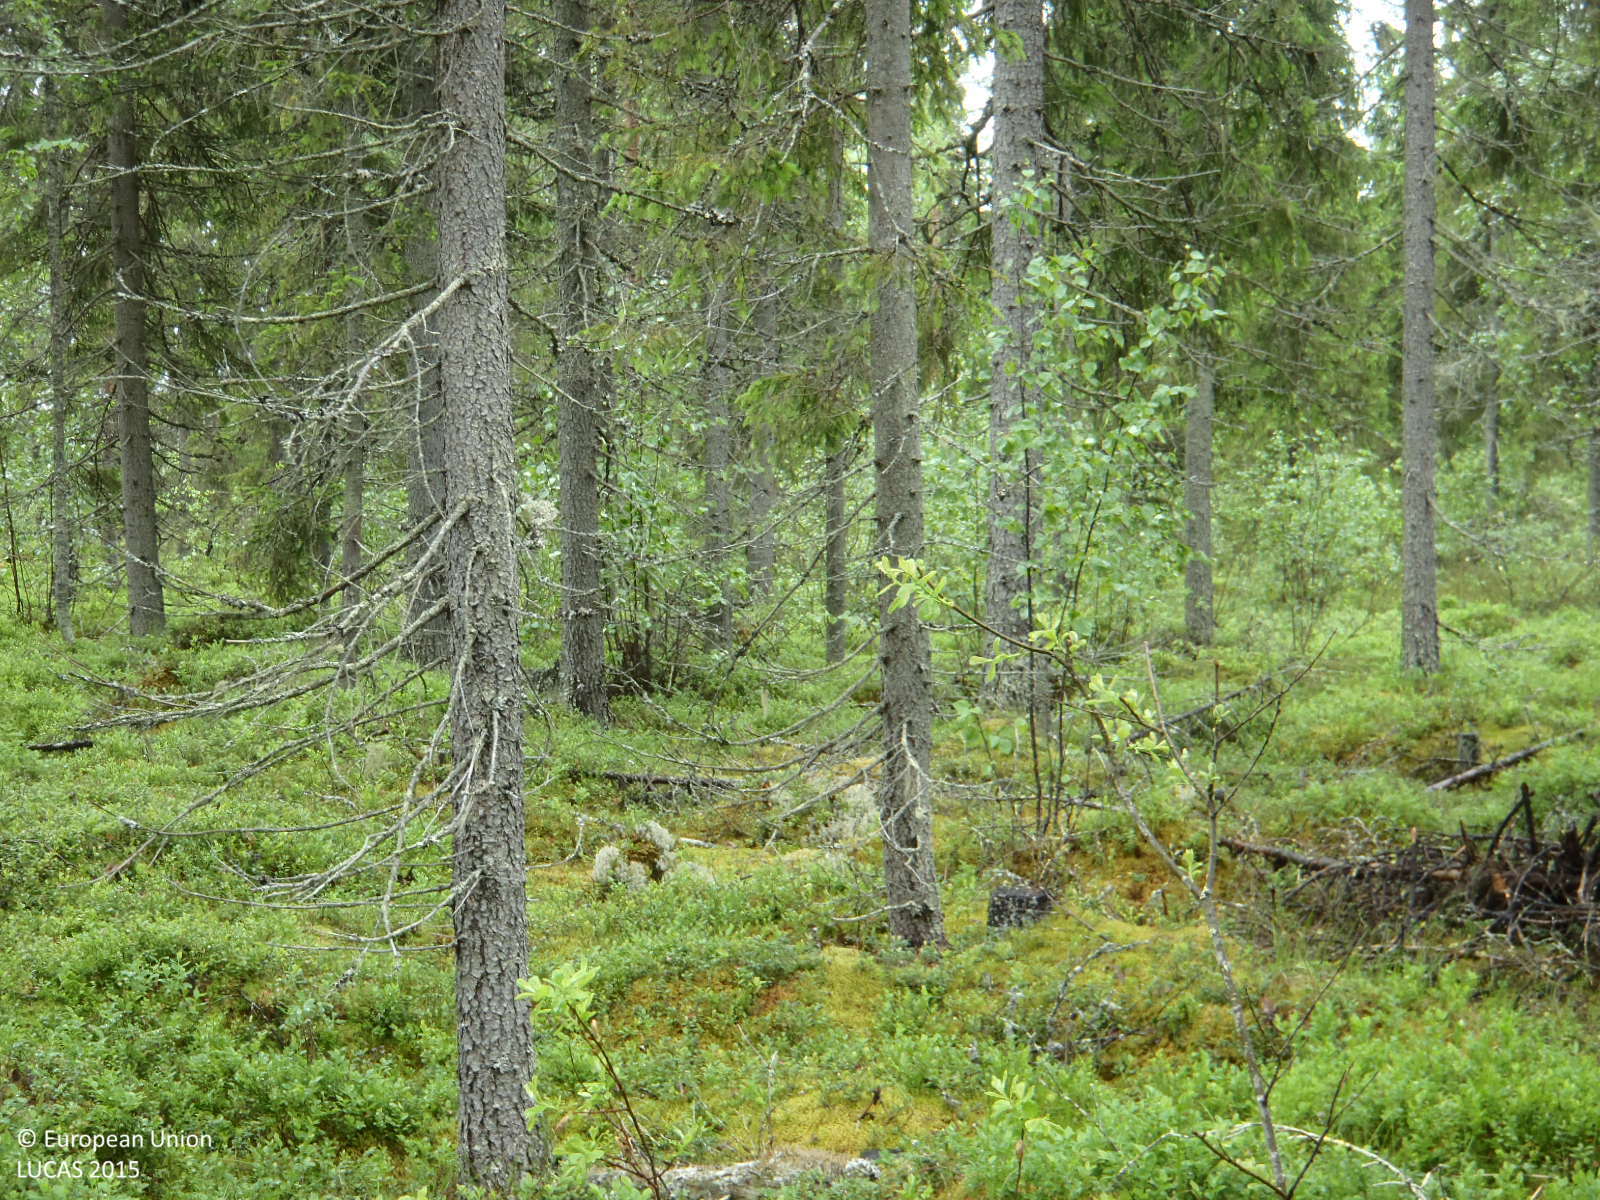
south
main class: Woodland
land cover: Spruce dominated coniferous woodland
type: boreal forest
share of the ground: 50 - 75 %
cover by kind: coniferous forest trees 55 %, shrubs 25 %, lichens and mosses 10 %, broadleaved forest trees 5 %, herbaceous plants 5 %
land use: Forestry
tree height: > 5 m
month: June
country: FI
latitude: 63.9811
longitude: 26.5706
